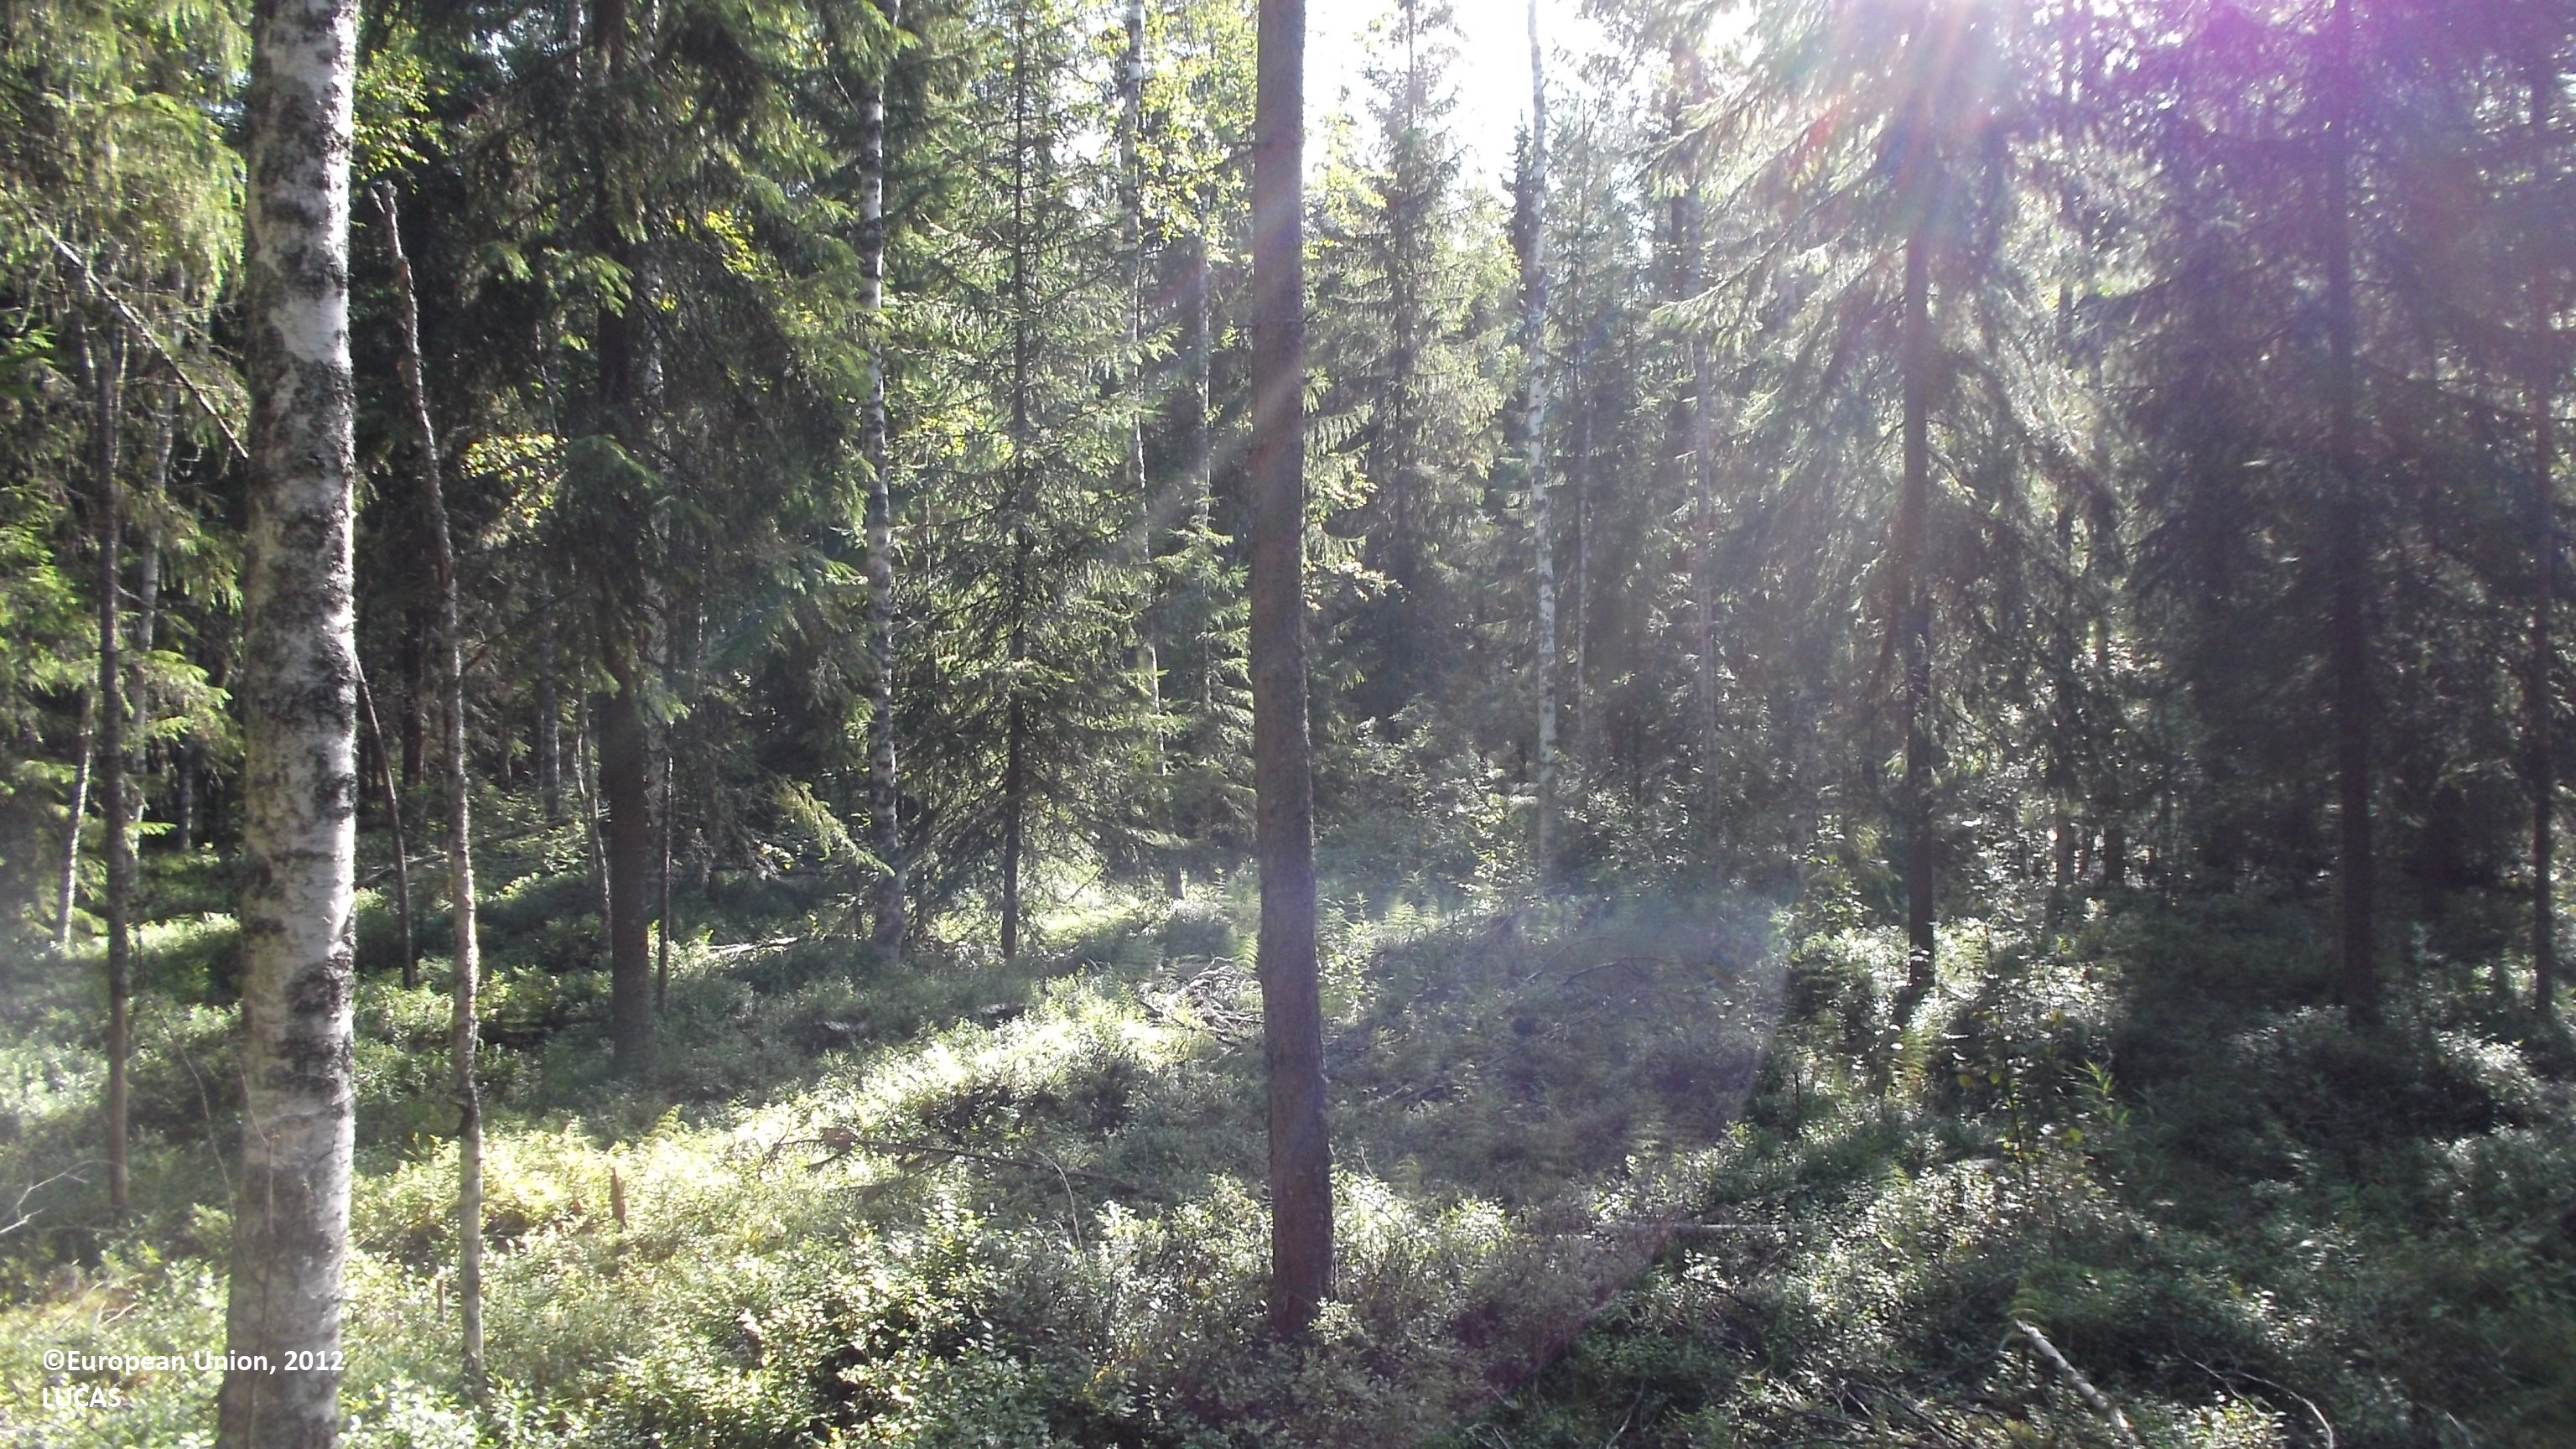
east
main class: Woodland
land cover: Other mixed woodland
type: boreal forest
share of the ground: 25 - 50 %
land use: Forestry
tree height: > 5 m
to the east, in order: Other mixed woodland; Spruce dominated mixed woodland; Tracks; Spruce dominated mixed woodland; Ditches and canals; Grass margins; Barley
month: July
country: FI
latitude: 63.6125
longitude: 22.8981
